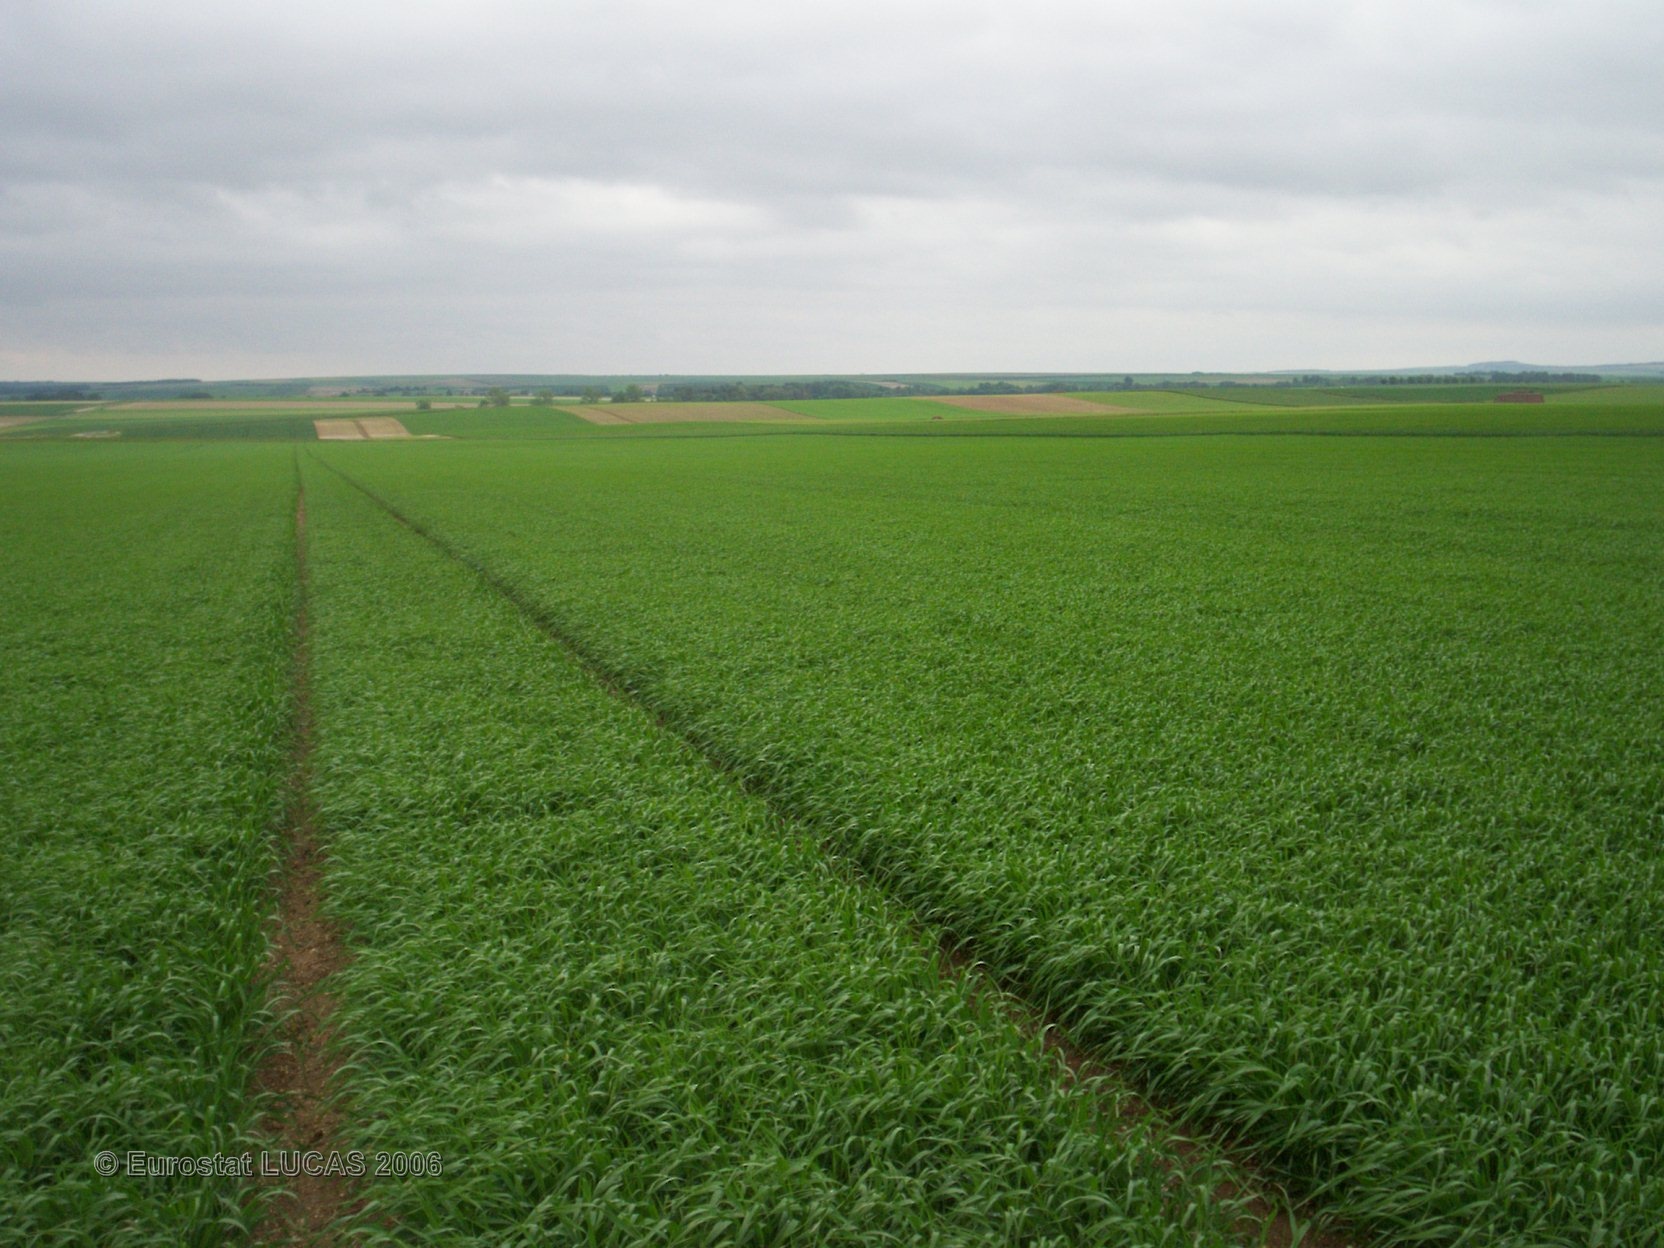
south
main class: Cropland
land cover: Barley
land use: Agriculture (excluding fallow land and kitchen gardens)
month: May
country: FR
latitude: 49.3267
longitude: 4.4236
